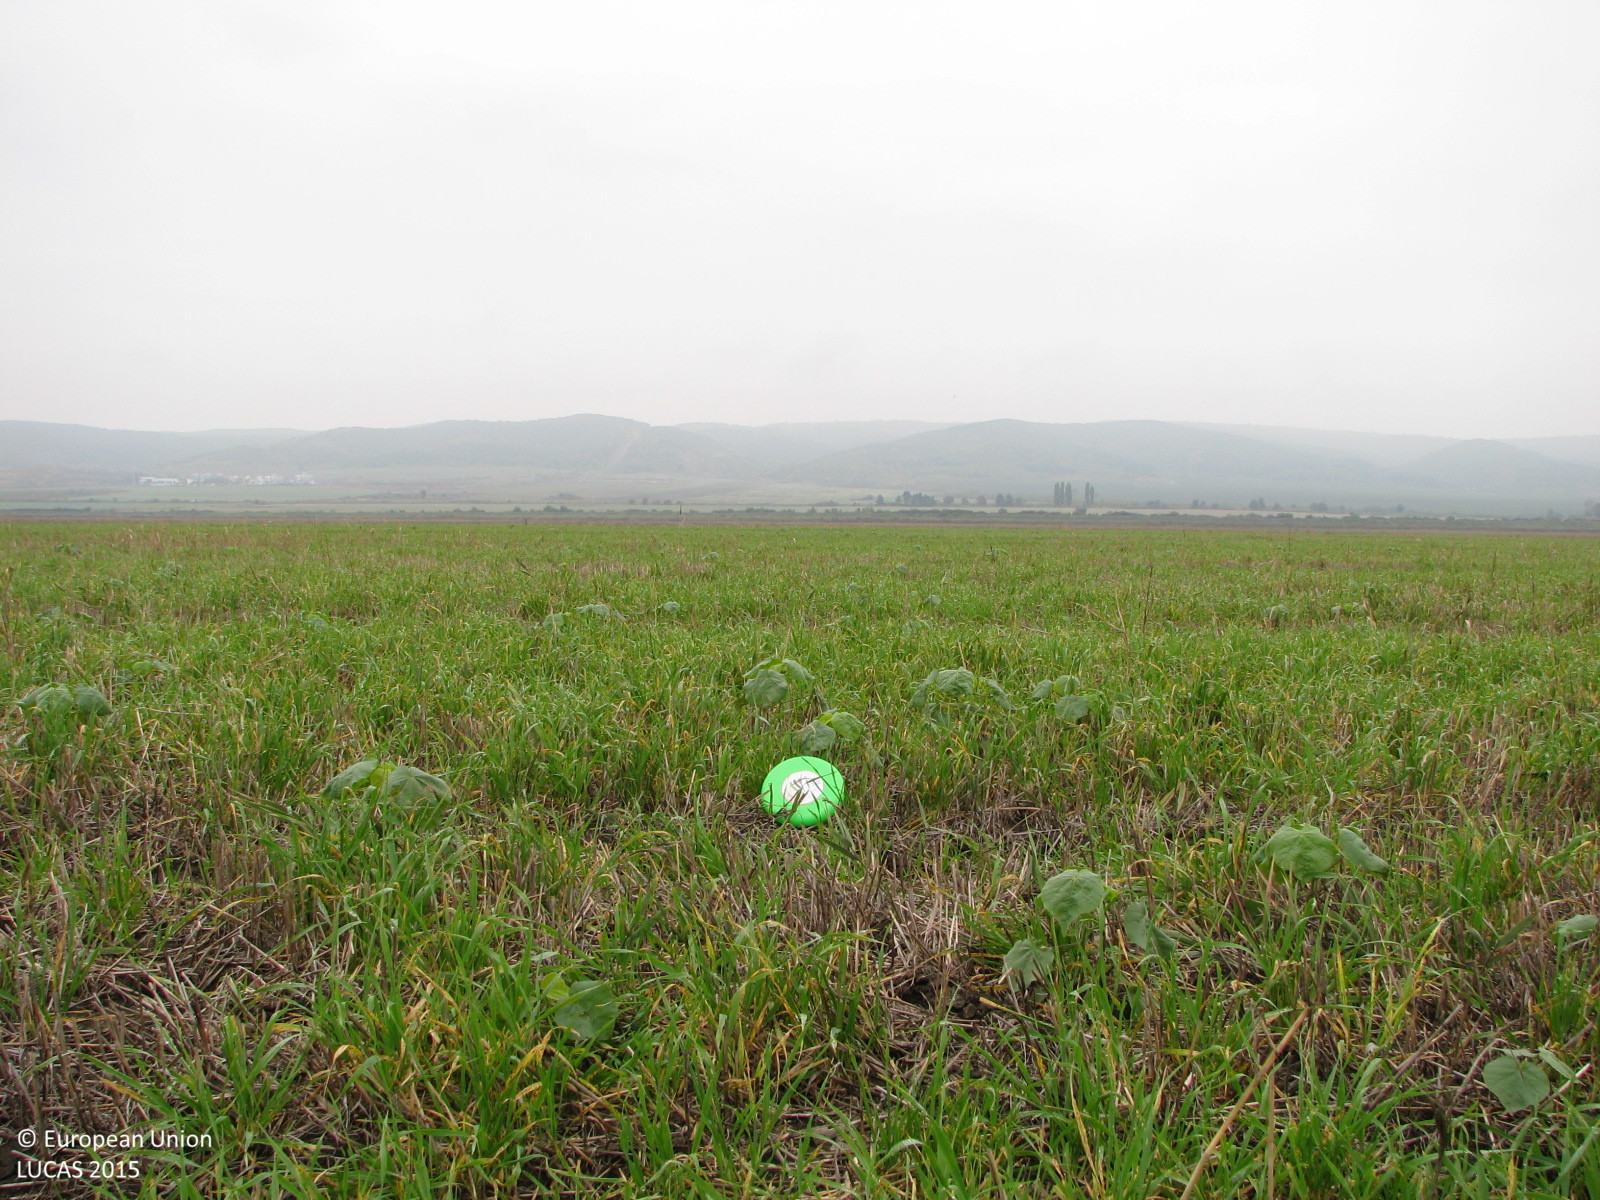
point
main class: Cropland
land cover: Common wheat
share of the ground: > 75 %
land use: Agriculture (excluding fallow land and kitchen gardens)
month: October
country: BG
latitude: 42.6287
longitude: 26.7441
